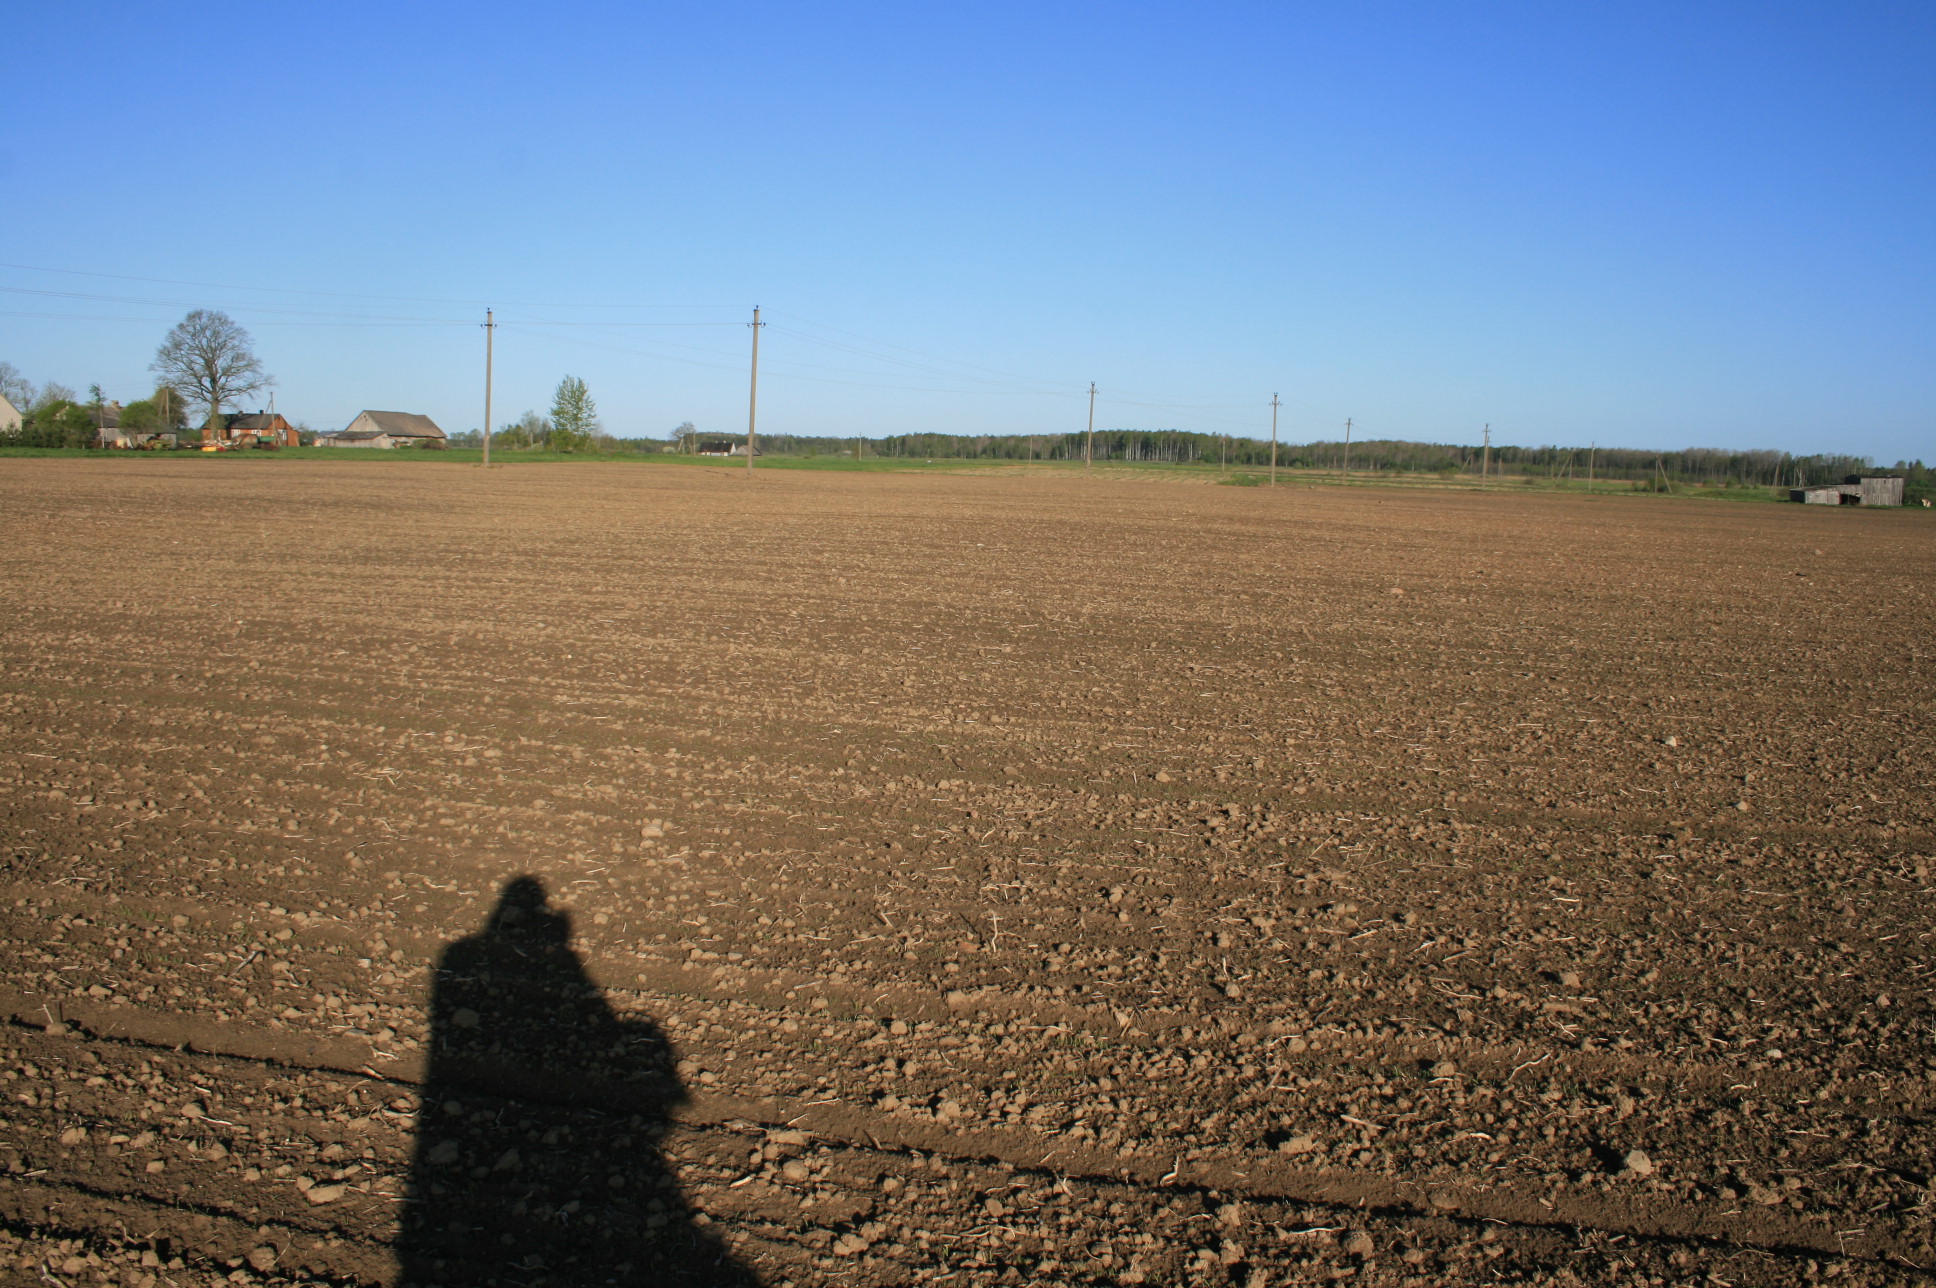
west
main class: Cropland
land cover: Common wheat
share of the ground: 10 - 25 %
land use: Agriculture (excluding fallow land and kitchen gardens)
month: May
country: LT
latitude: 56.2696
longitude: 21.4915
